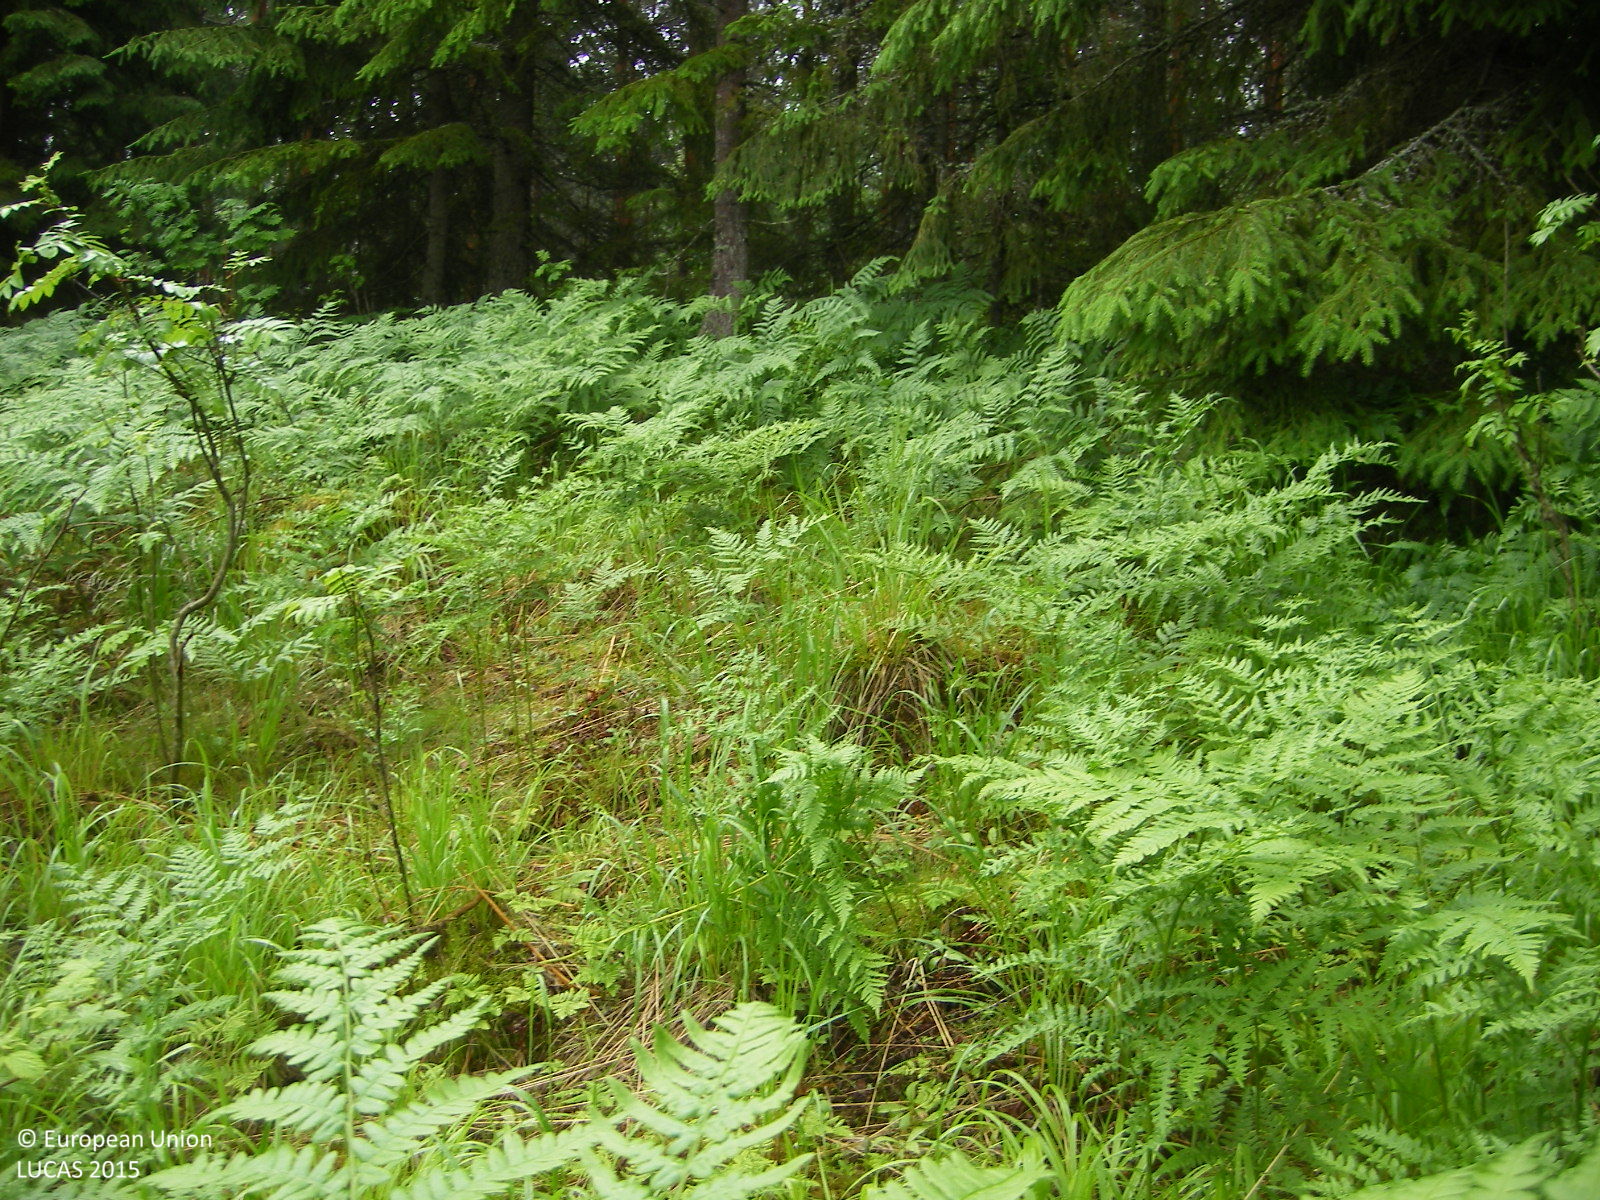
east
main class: Grassland
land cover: Spontaneously vegetated surfaces
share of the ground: > 75 %
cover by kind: herbaceous plants 100 %
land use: Forestry
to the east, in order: Spontaneously vegetated surfaces; Pine dominated mixed woodland; Ditches and canals; Spruce dominated mixed woodland; Ditches and canals; Dry stone walls; Spontaneously vegetated surfaces; Spruce dominated mixed woodland
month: June
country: FI
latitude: 60.4088
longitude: 23.2818
